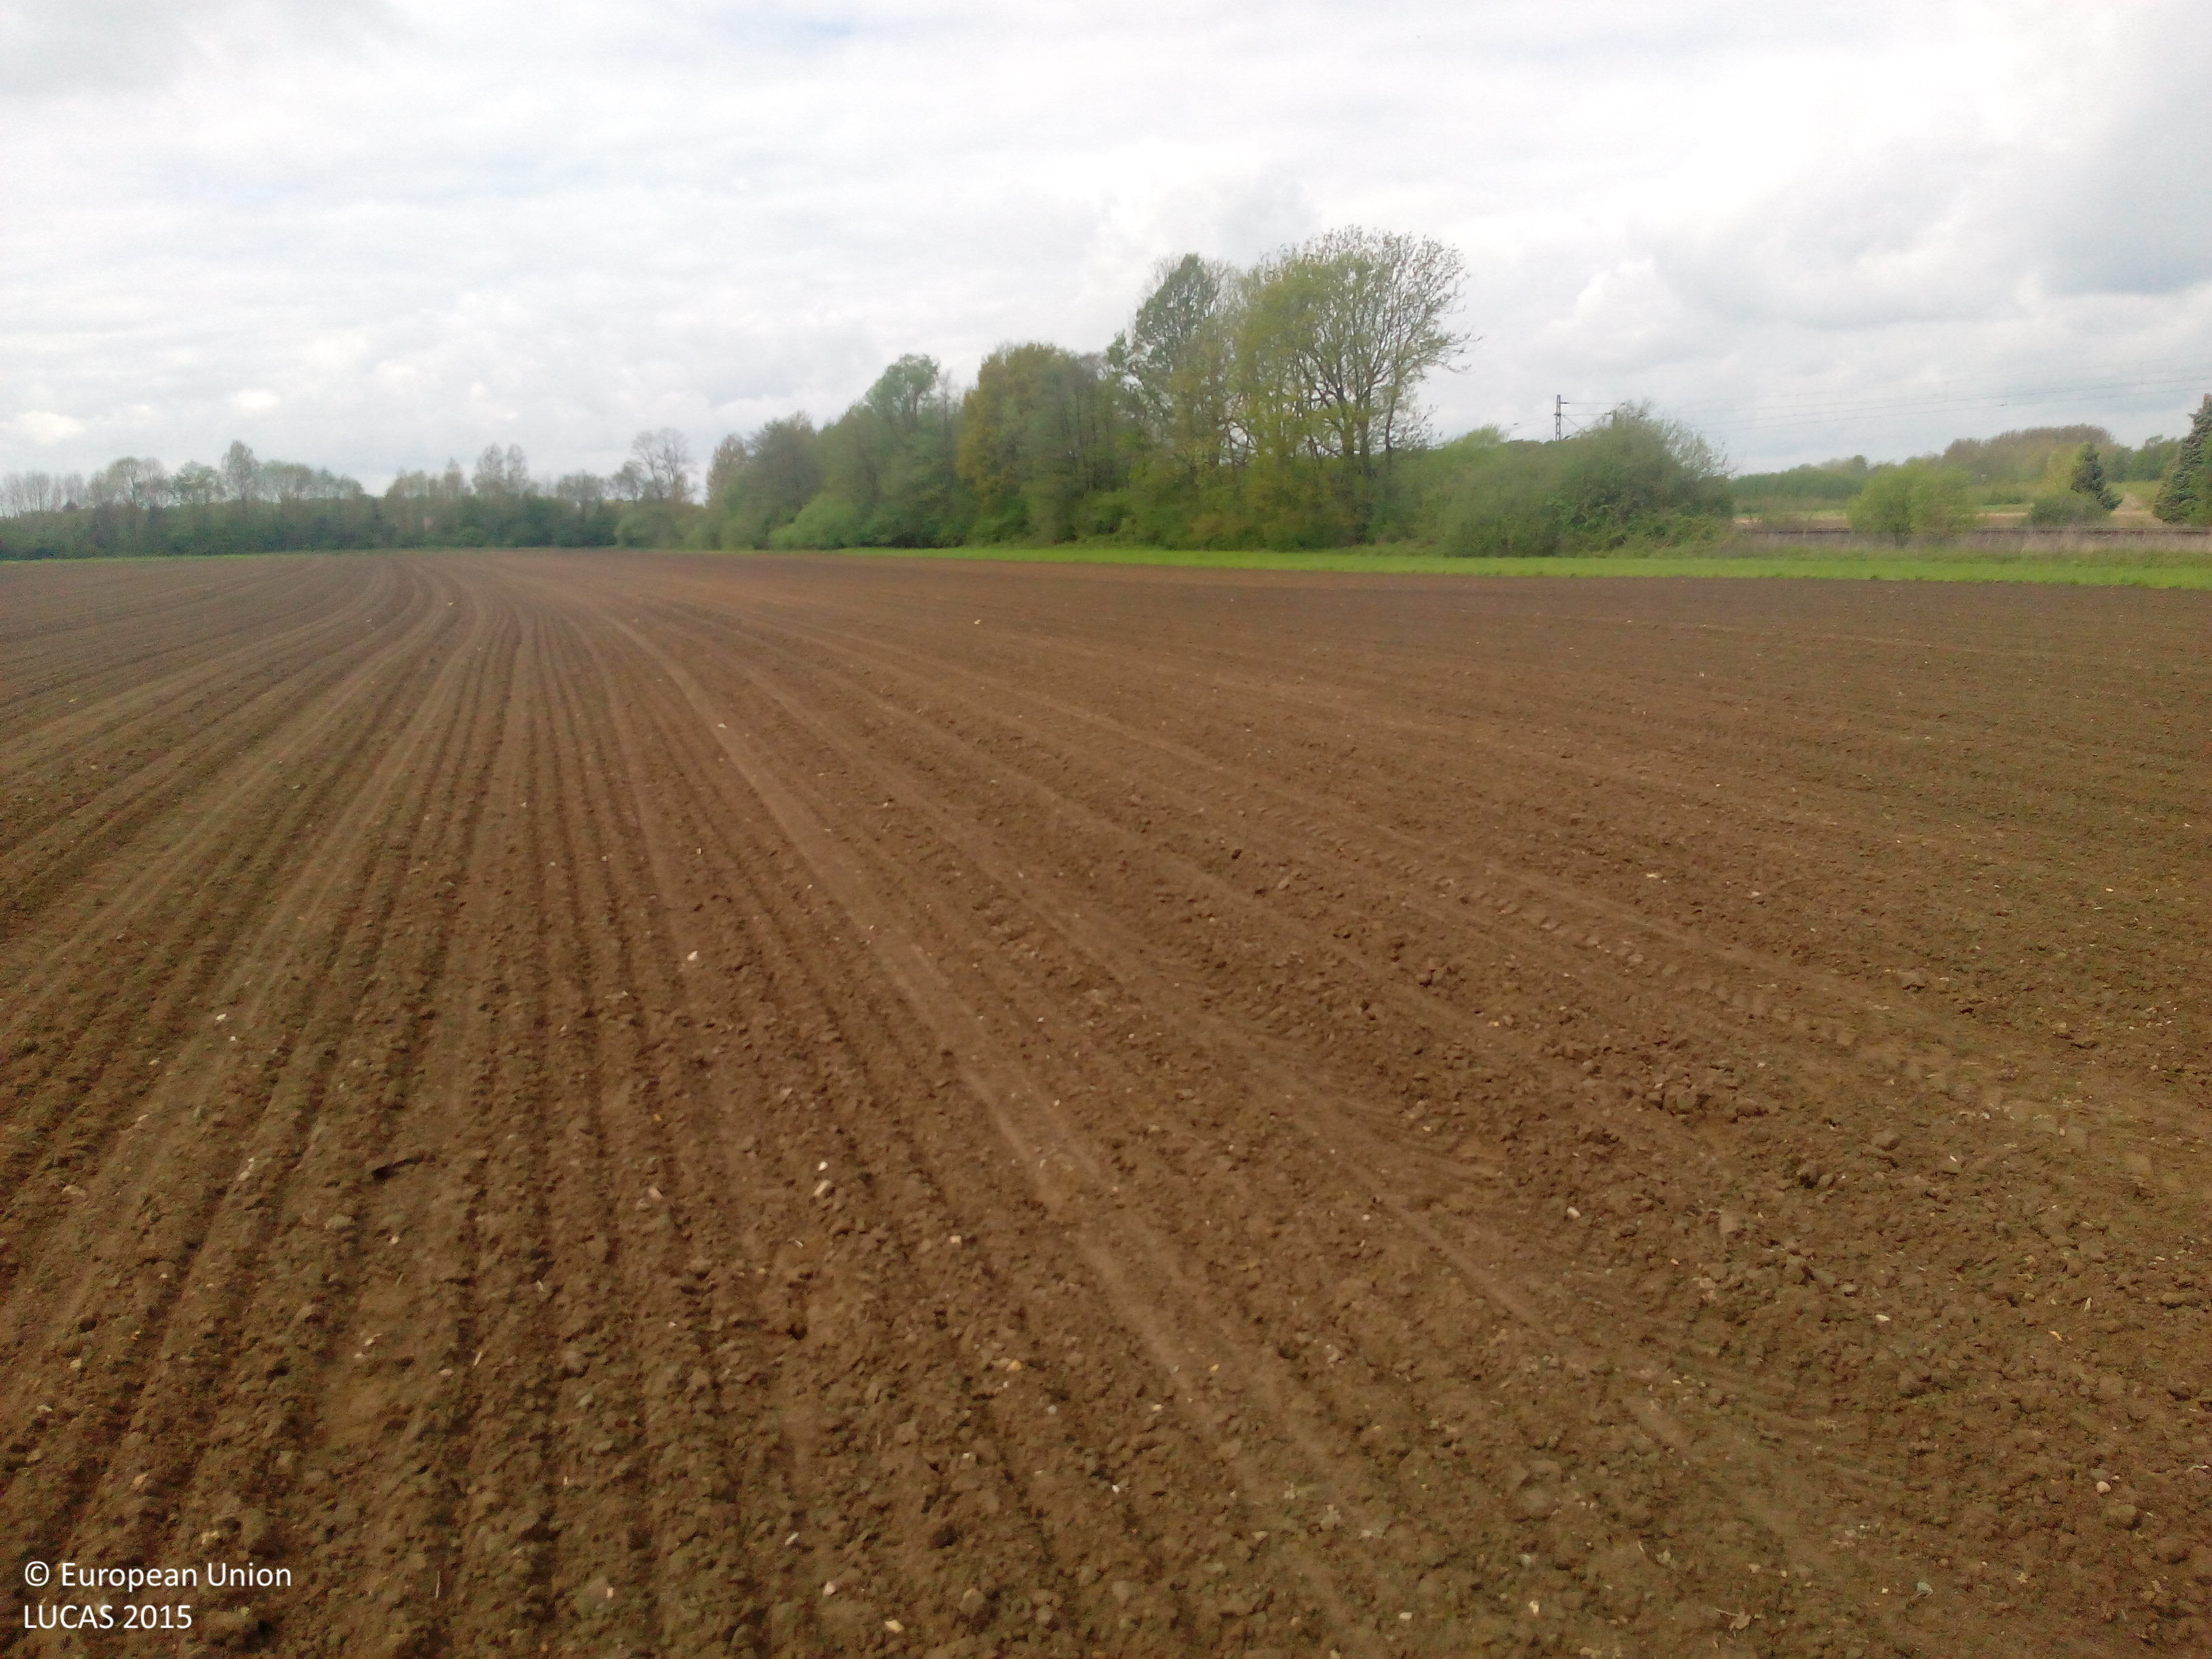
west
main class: Cropland
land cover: Maize
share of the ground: < 10 %
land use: Agriculture (excluding fallow land and kitchen gardens)
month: May
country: DE
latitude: 51.9007
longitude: 7.4569
